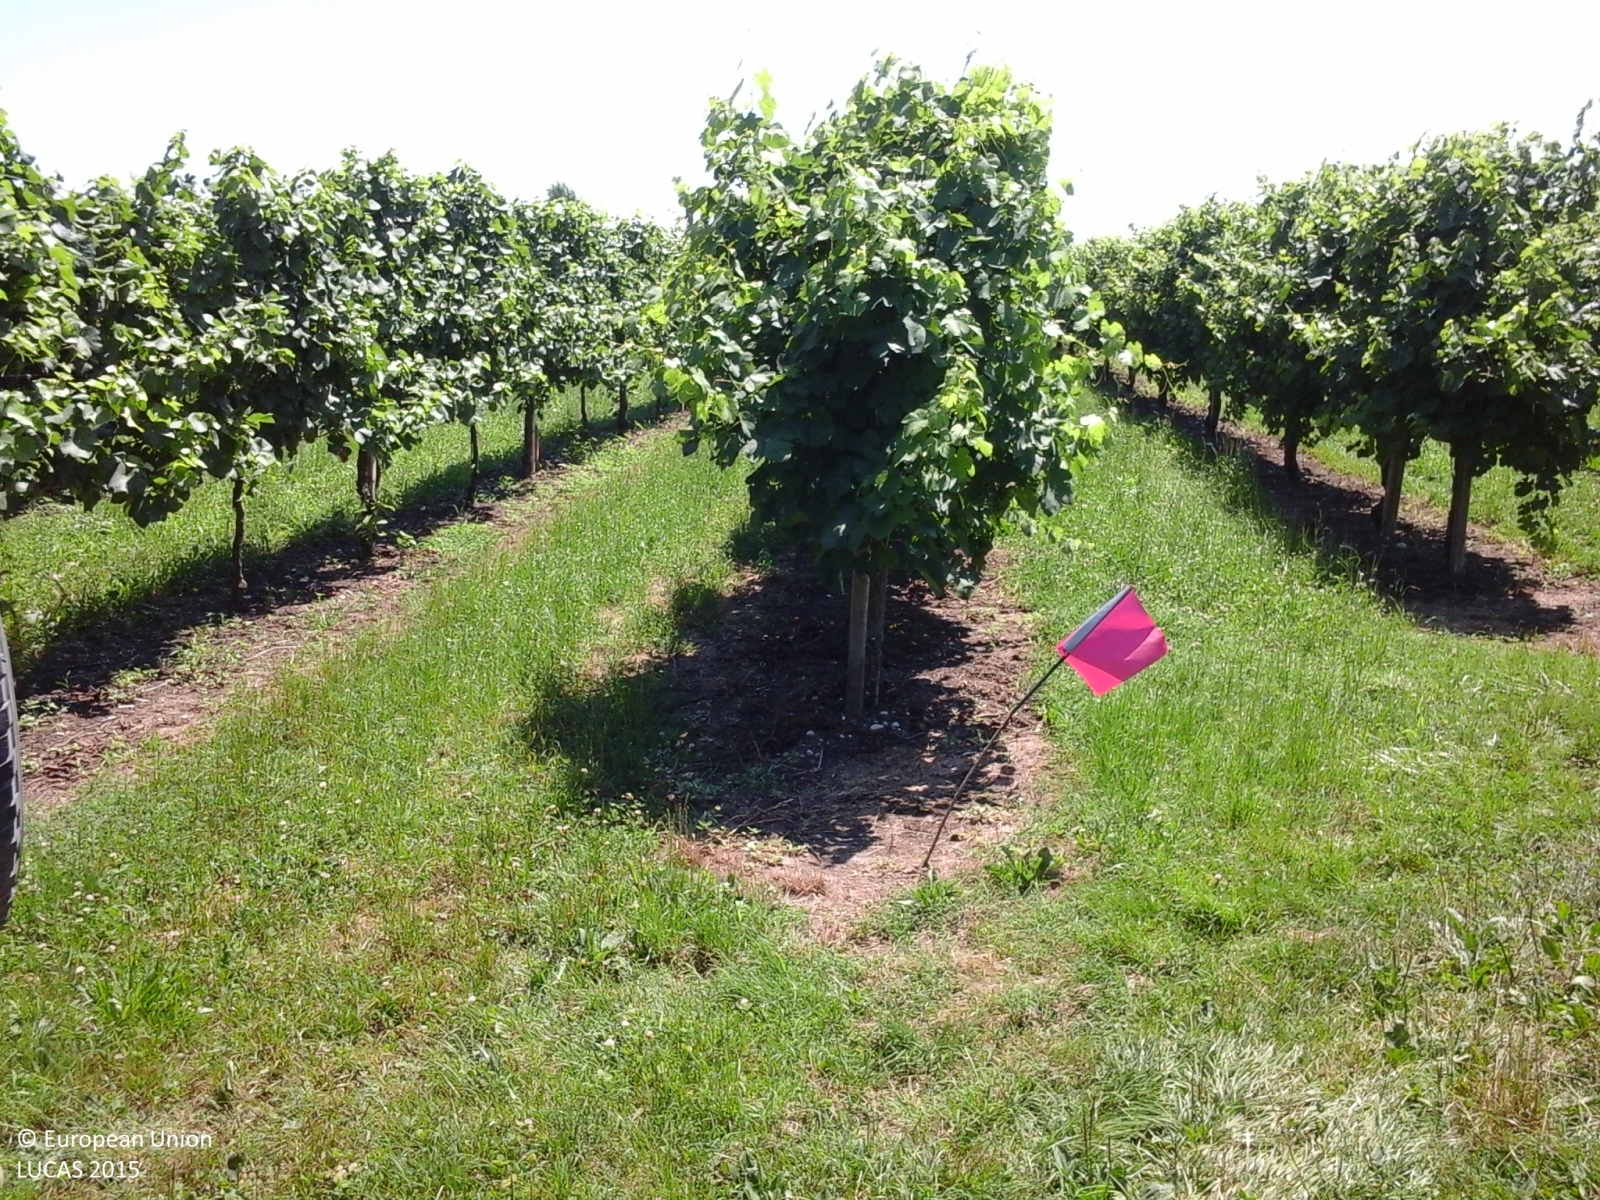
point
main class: Cropland
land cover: Vineyards
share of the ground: 25 - 50 %
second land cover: Grassland without tree/shrub cover
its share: > 75 %
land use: Agriculture (excluding fallow land and kitchen gardens)
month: July
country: IT
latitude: 45.8027
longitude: 12.3513
